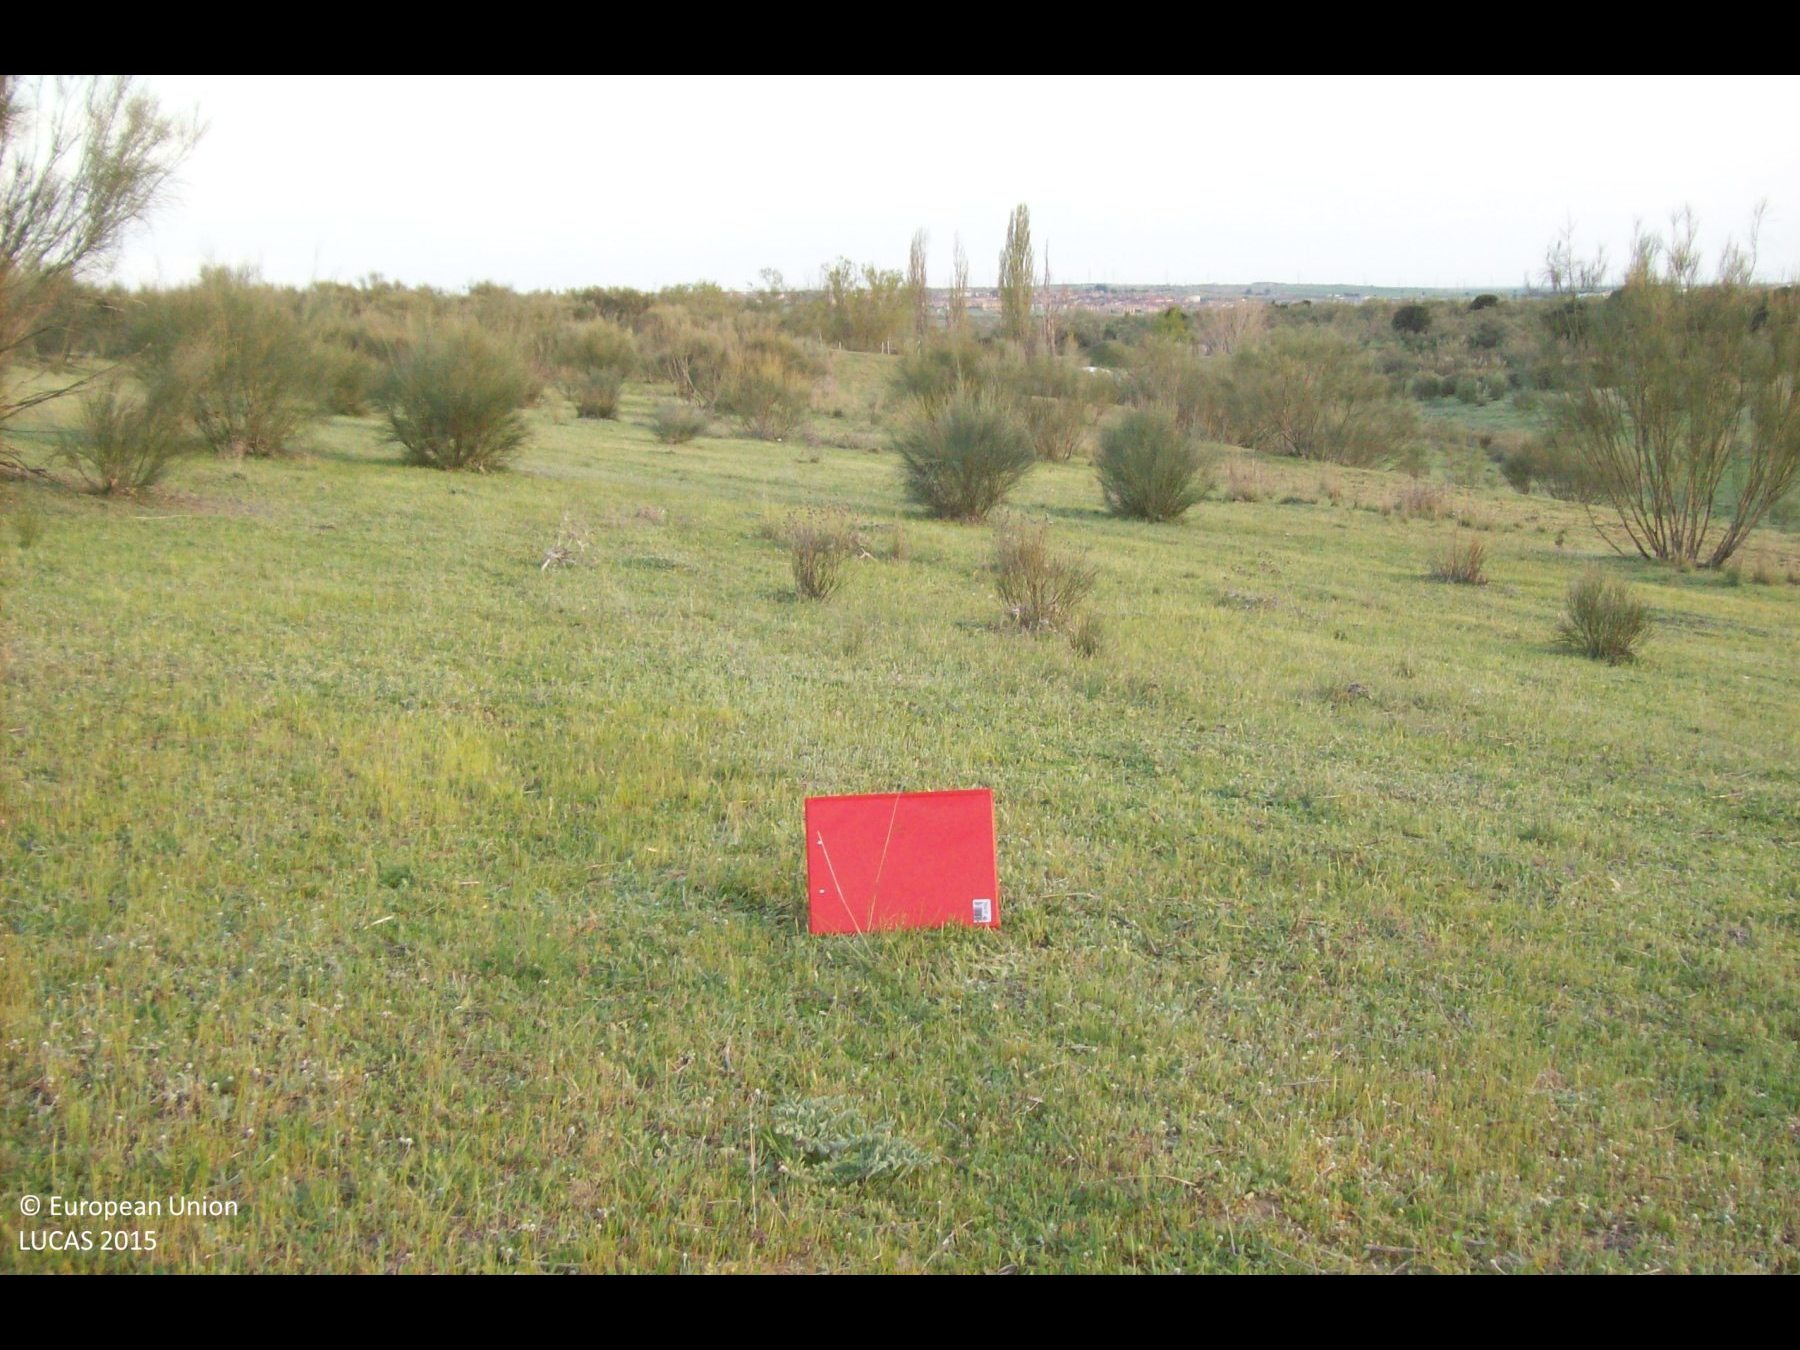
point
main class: Shrubland
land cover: Shrubland without tree cover
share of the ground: 10 - 25 %
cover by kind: herbaceous plants 90 %, shrubs 10 %
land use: Semi-natural and natural areas not in use
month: April
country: ES
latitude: 40.3896
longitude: -3.9056
